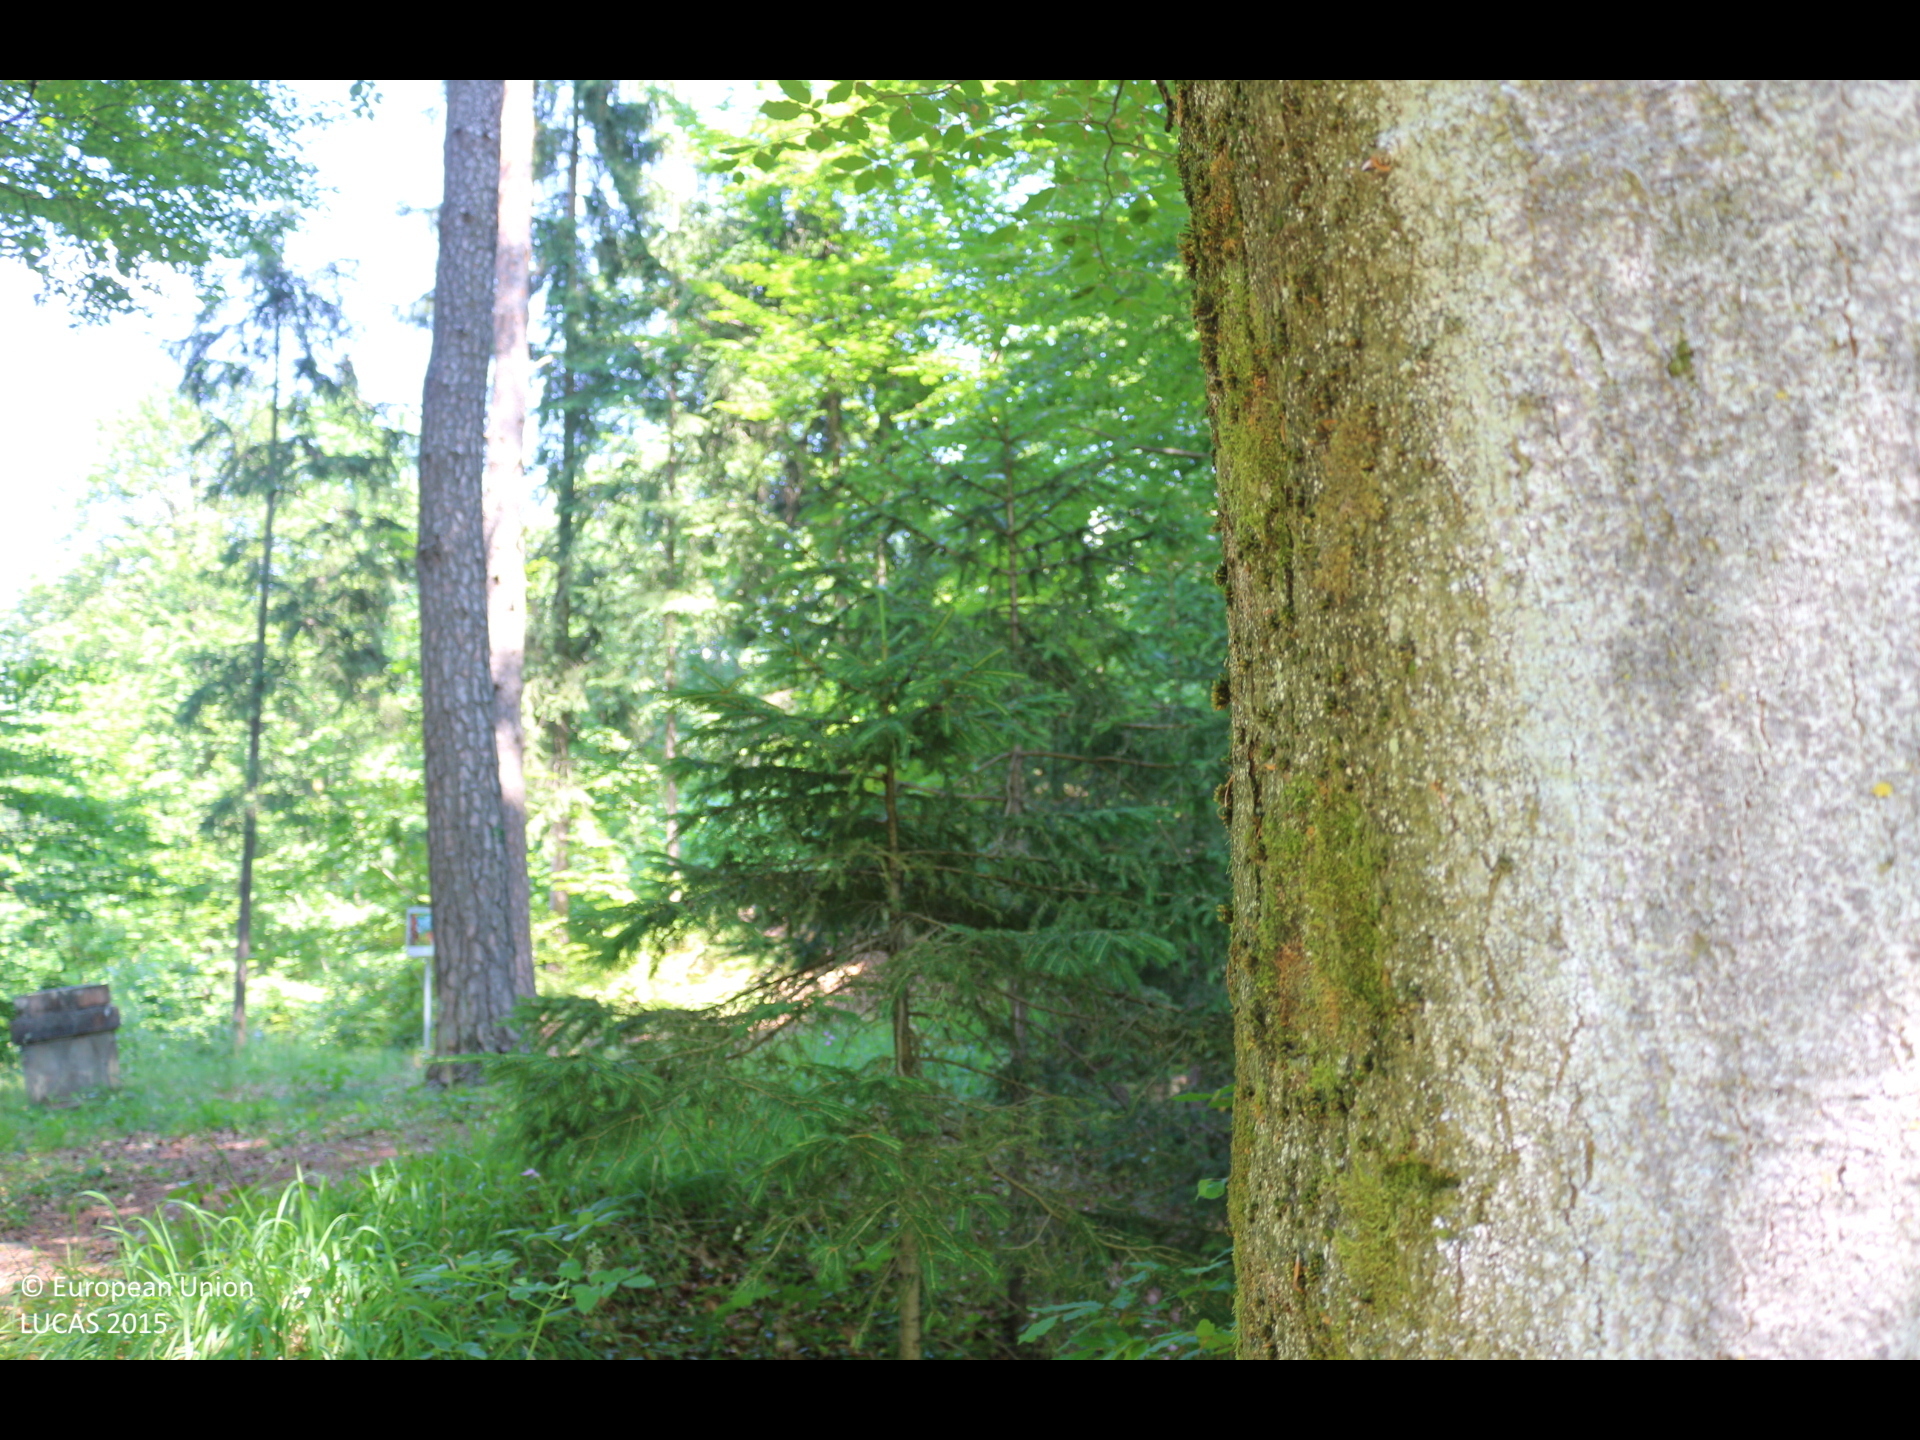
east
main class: Woodland
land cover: Broadleaved woodland
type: mountainous beech forest
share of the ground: > 75 %
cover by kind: broadleaved forest trees 95 %, coniferous forest trees 5 %
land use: Forestry
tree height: > 5 m
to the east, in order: Broadleaved woodland; Tracks; Broadleaved woodland; Artificial constructions in urban areas; Broadleaved woodland; Fences; Tracks
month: June
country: AT
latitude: 46.6217
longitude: 13.9281
